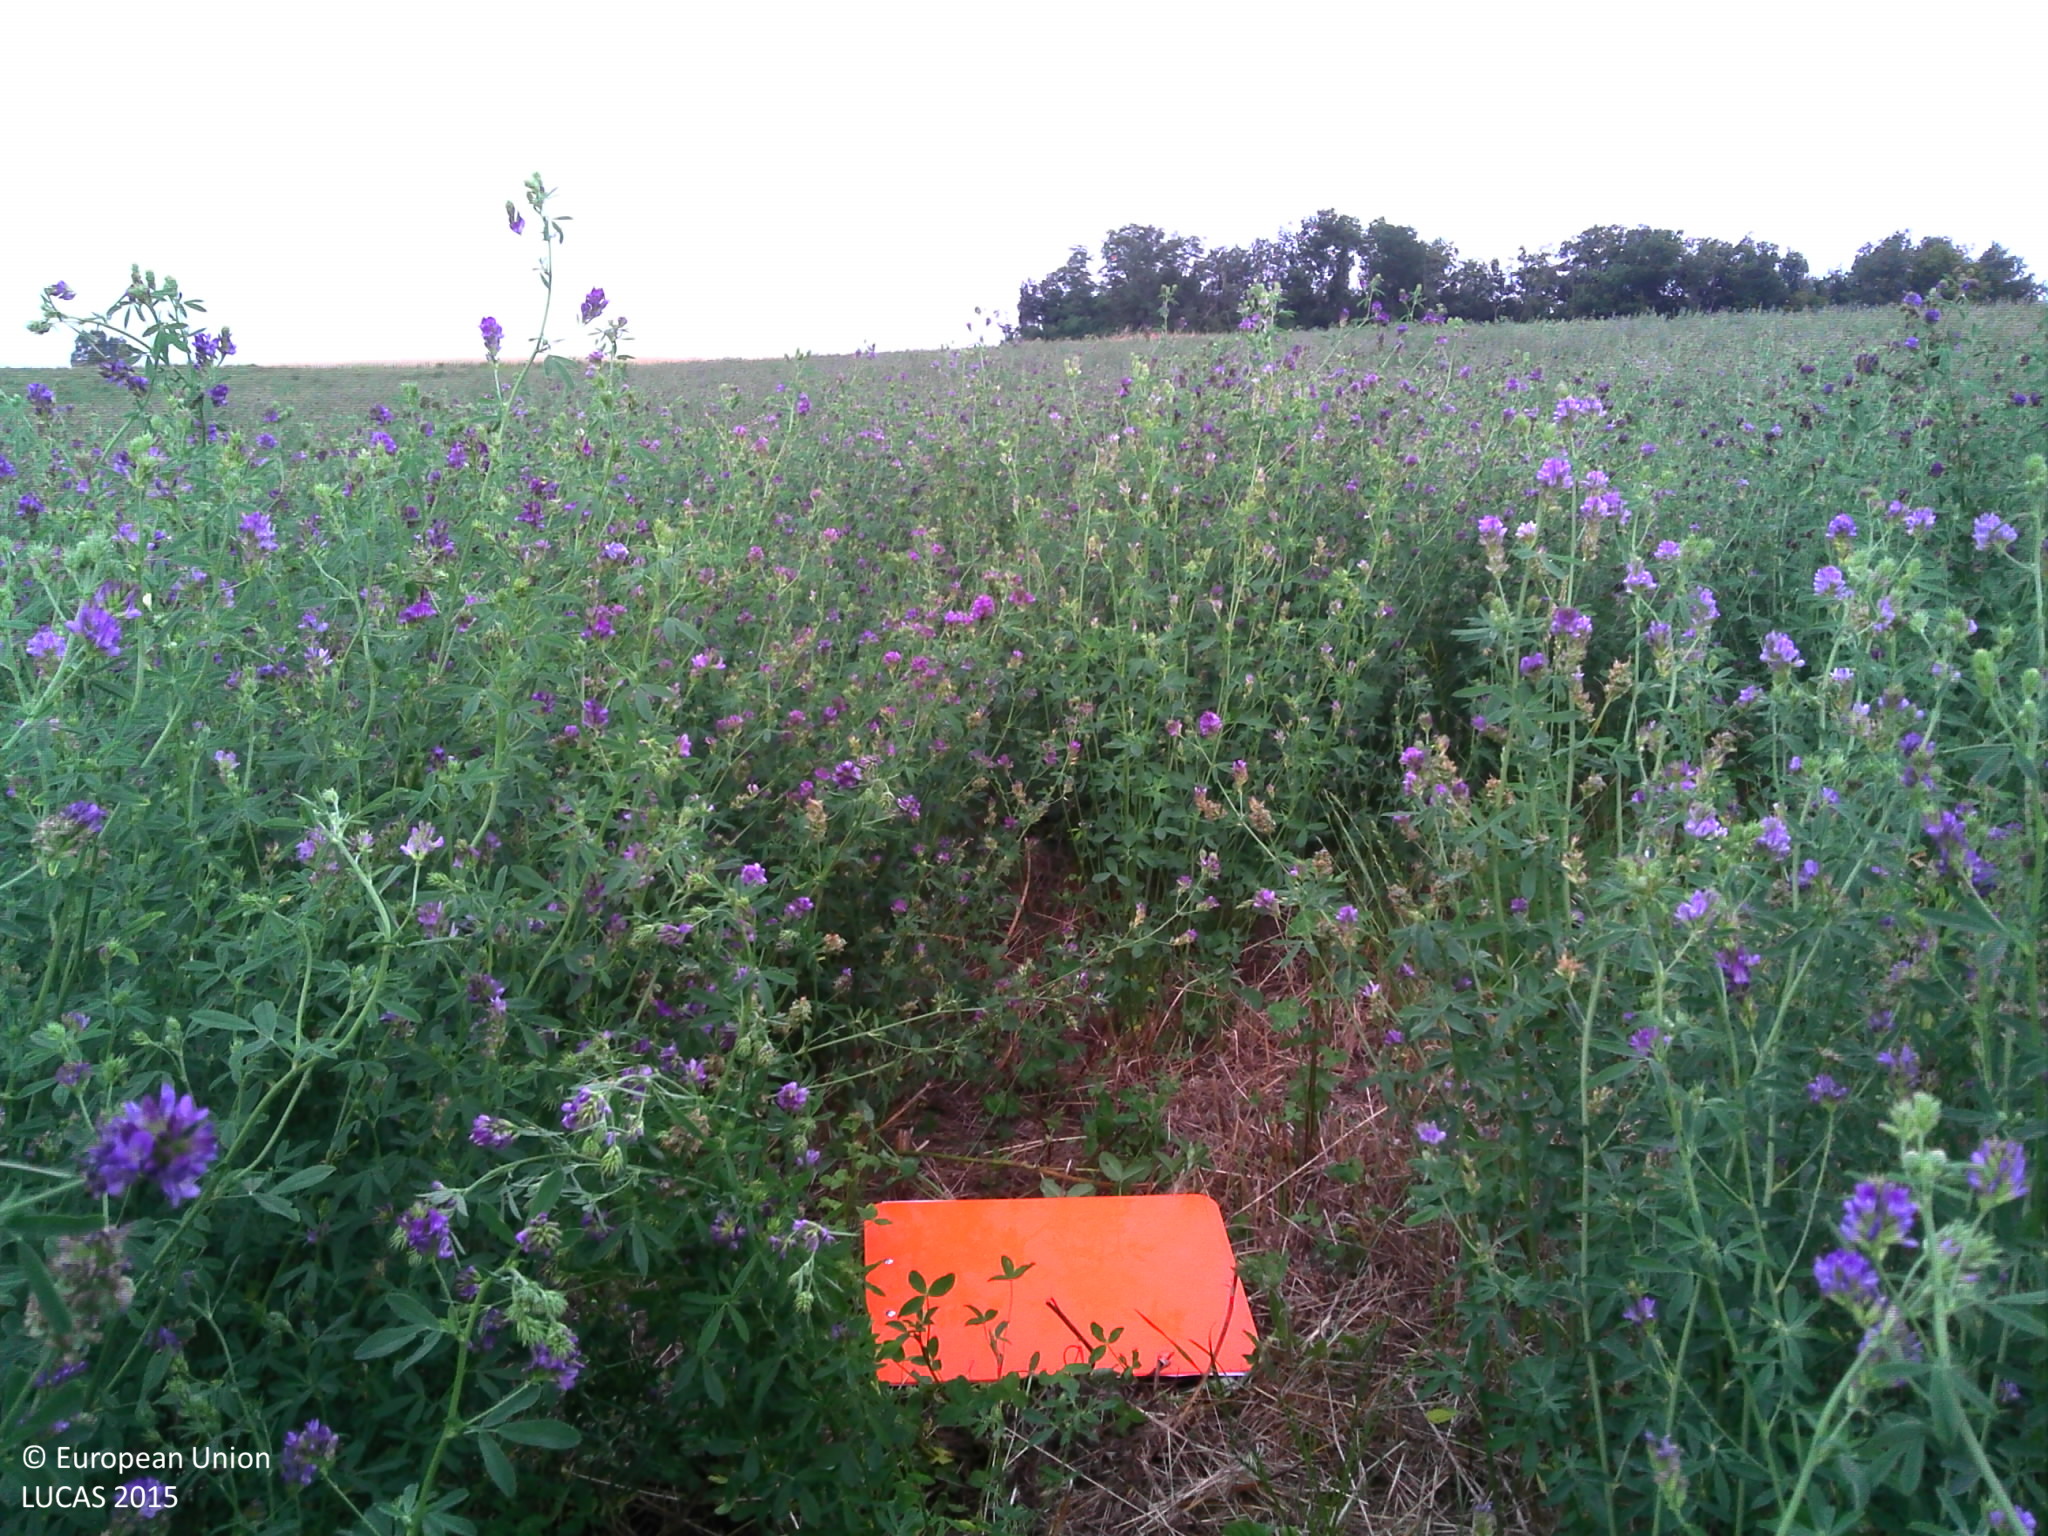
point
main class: Cropland
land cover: Lucerne
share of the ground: > 75 %
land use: Agriculture (excluding fallow land and kitchen gardens)
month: July
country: FR
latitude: 44.3470
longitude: 0.8758
